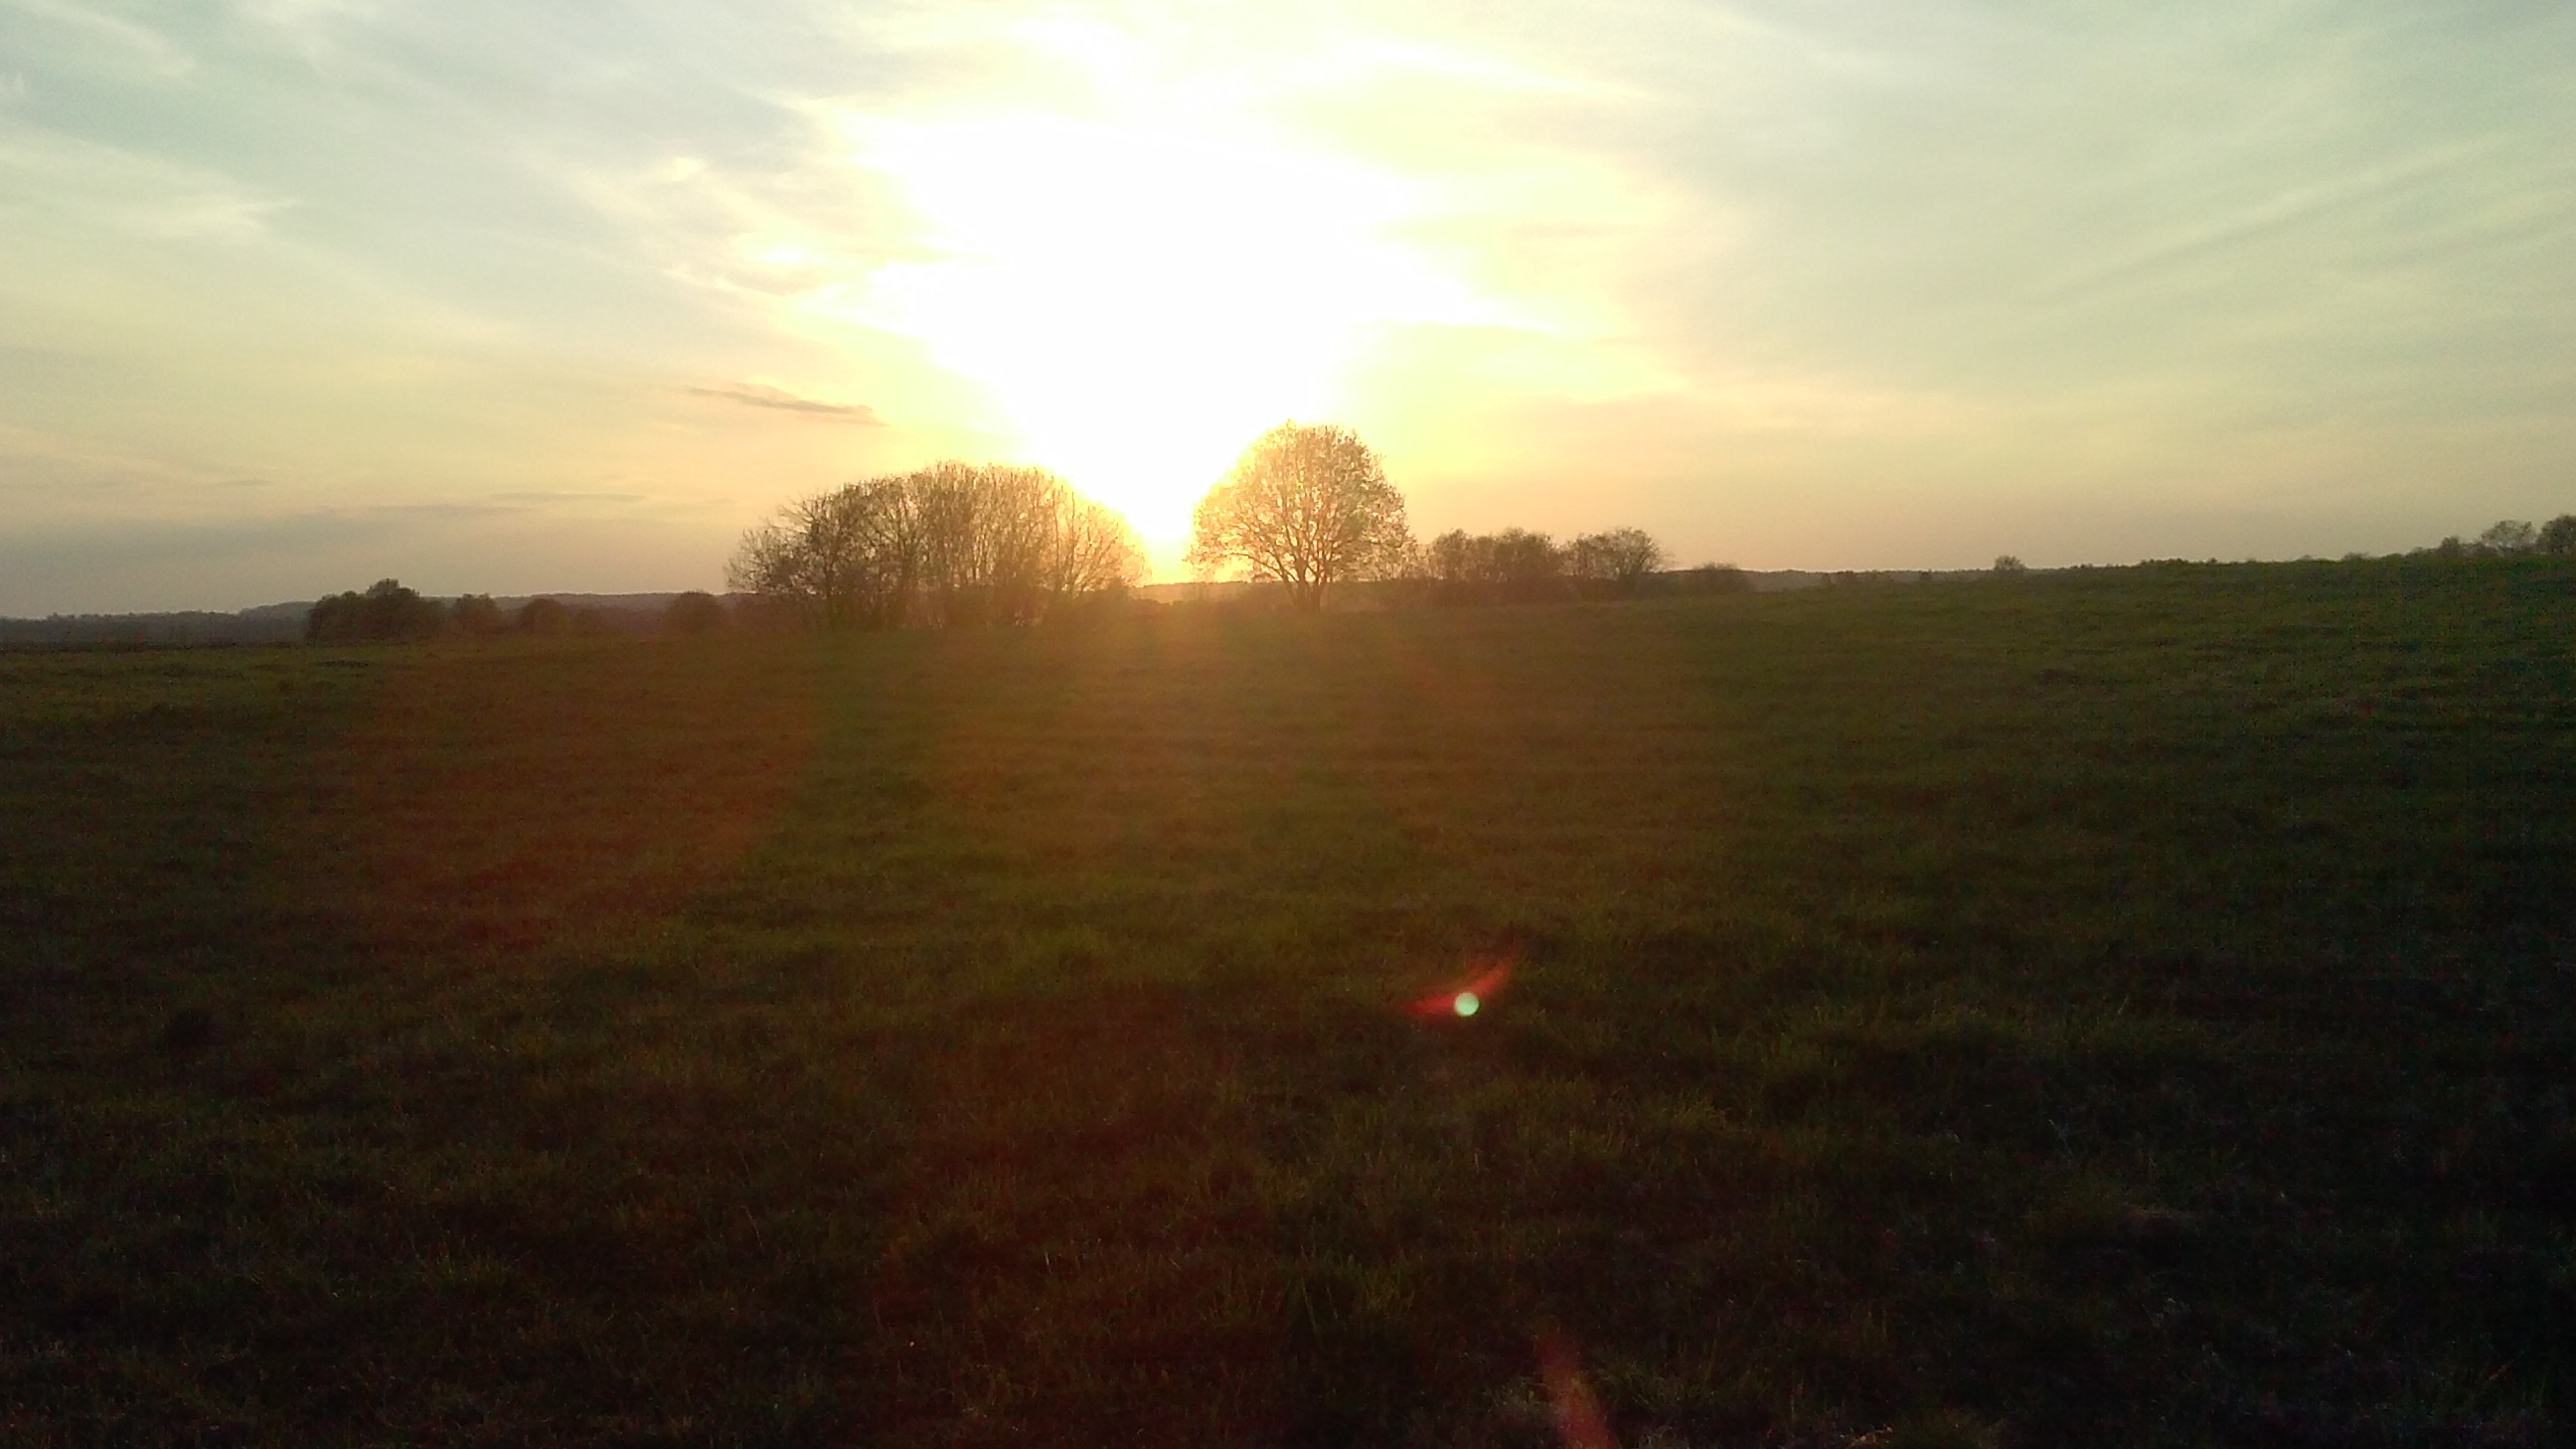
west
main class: Grassland
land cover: Grassland without tree/shrub cover
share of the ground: > 75 %
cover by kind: herbaceous plants 100 %
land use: Agriculture (excluding fallow land and kitchen gardens)
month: May
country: LV
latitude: 55.9279
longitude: 27.5158
